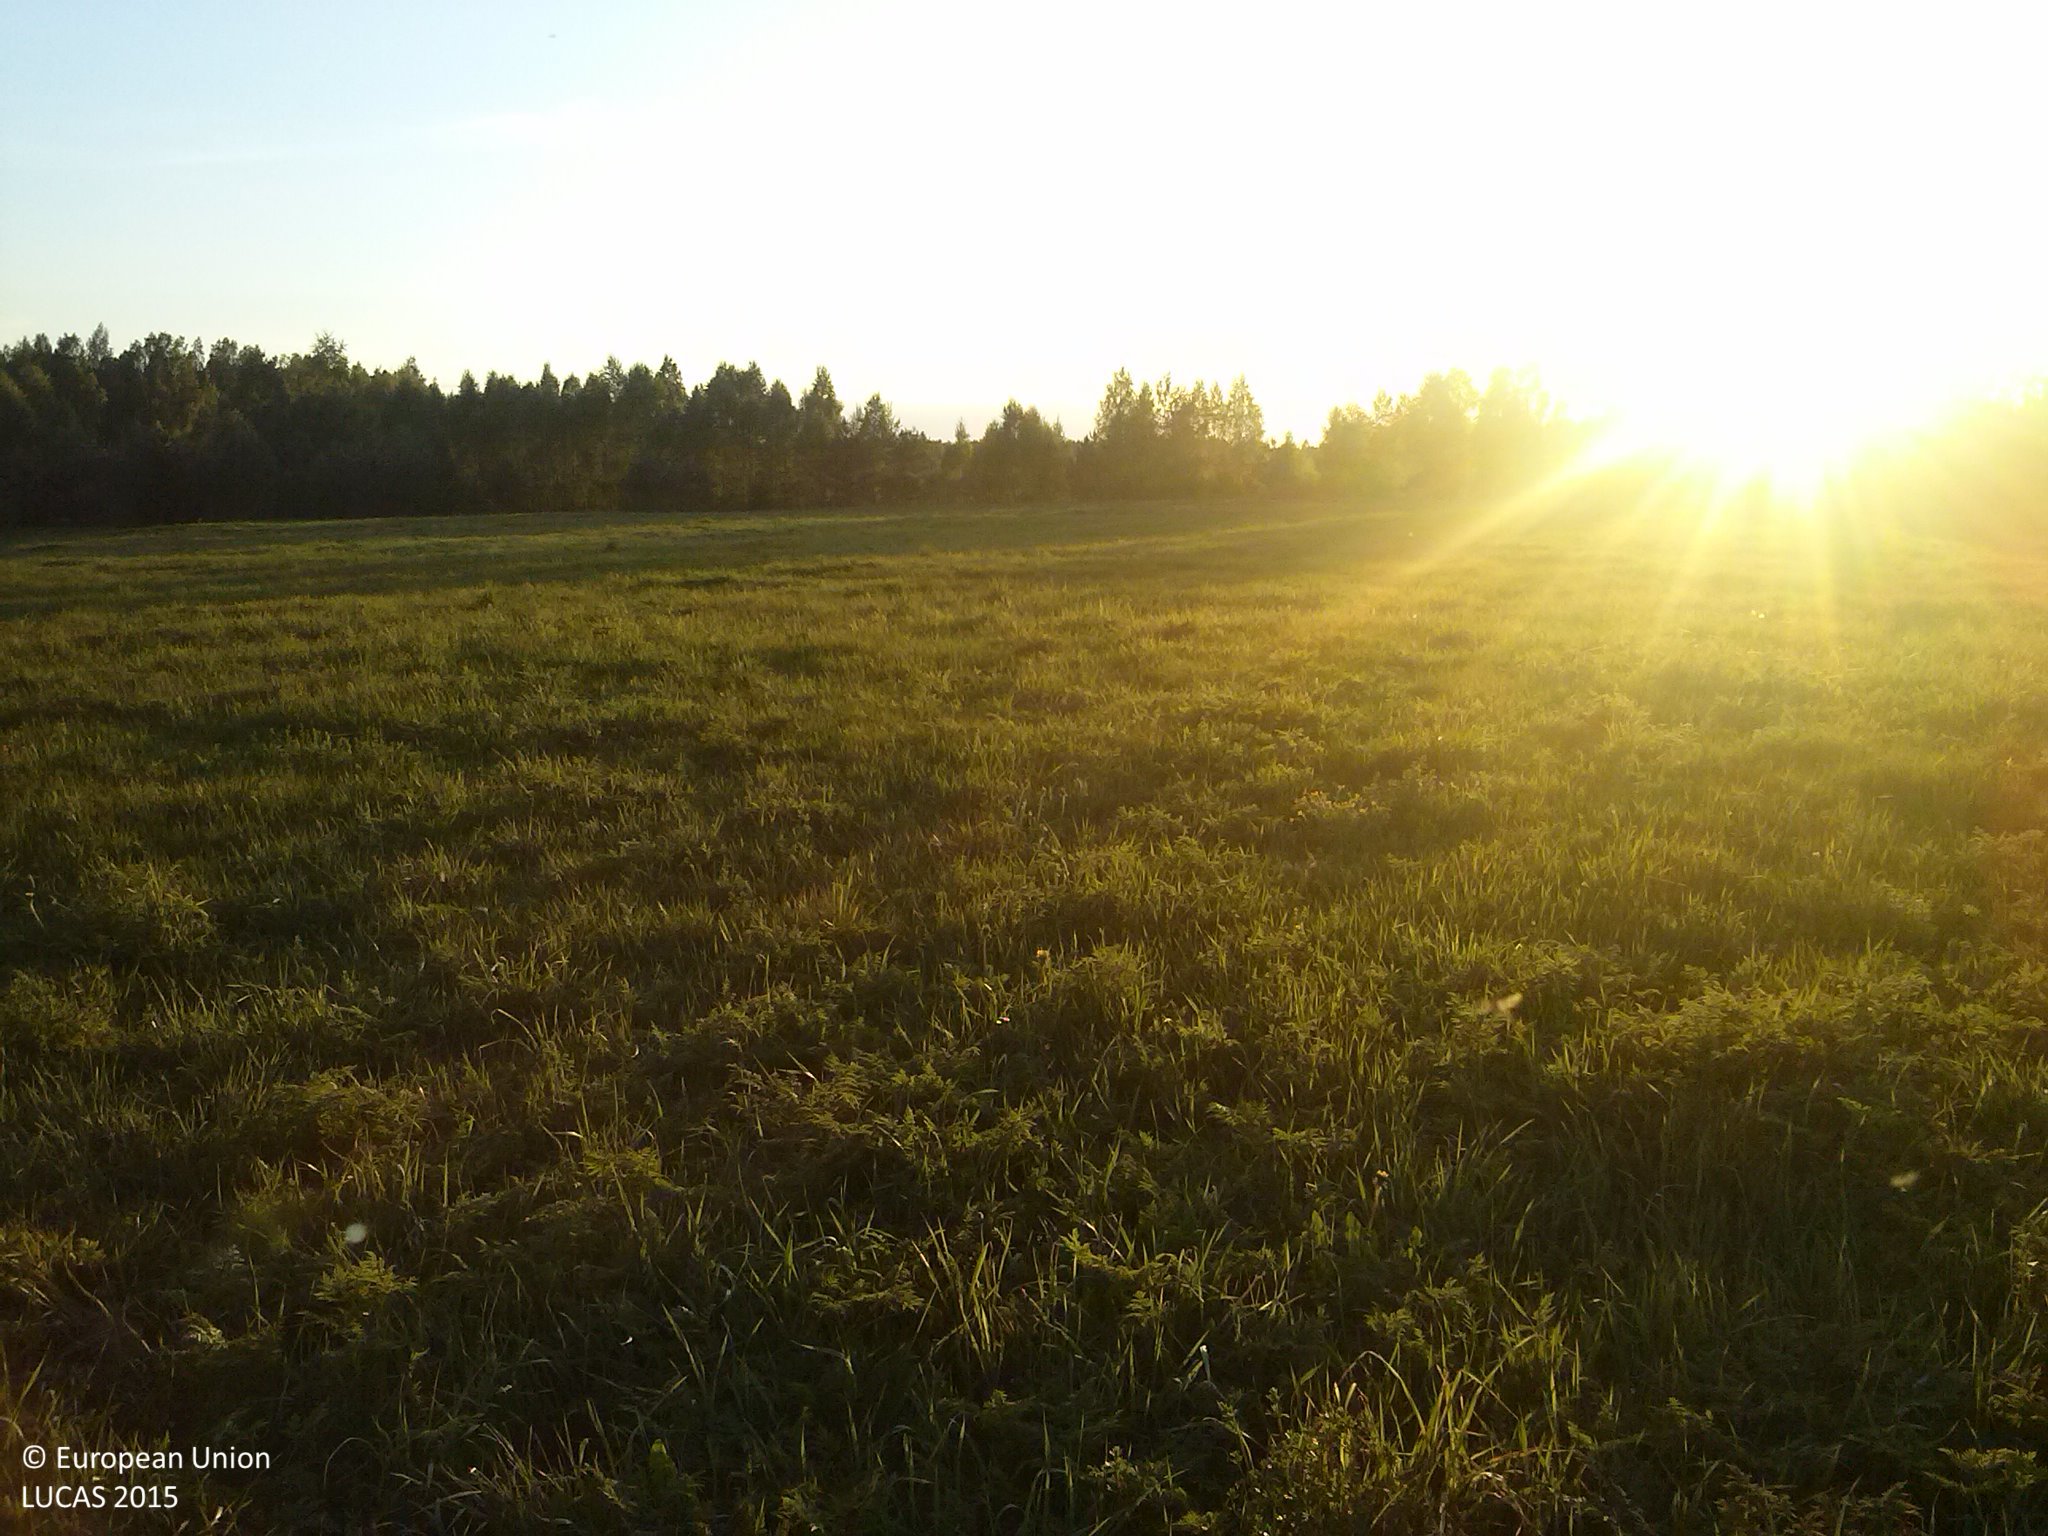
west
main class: Grassland
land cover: Grassland without tree/shrub cover
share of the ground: > 75 %
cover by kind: herbaceous plants 100 %
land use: Agriculture (excluding fallow land and kitchen gardens)
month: May
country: LV
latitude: 56.3182
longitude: 27.2284
